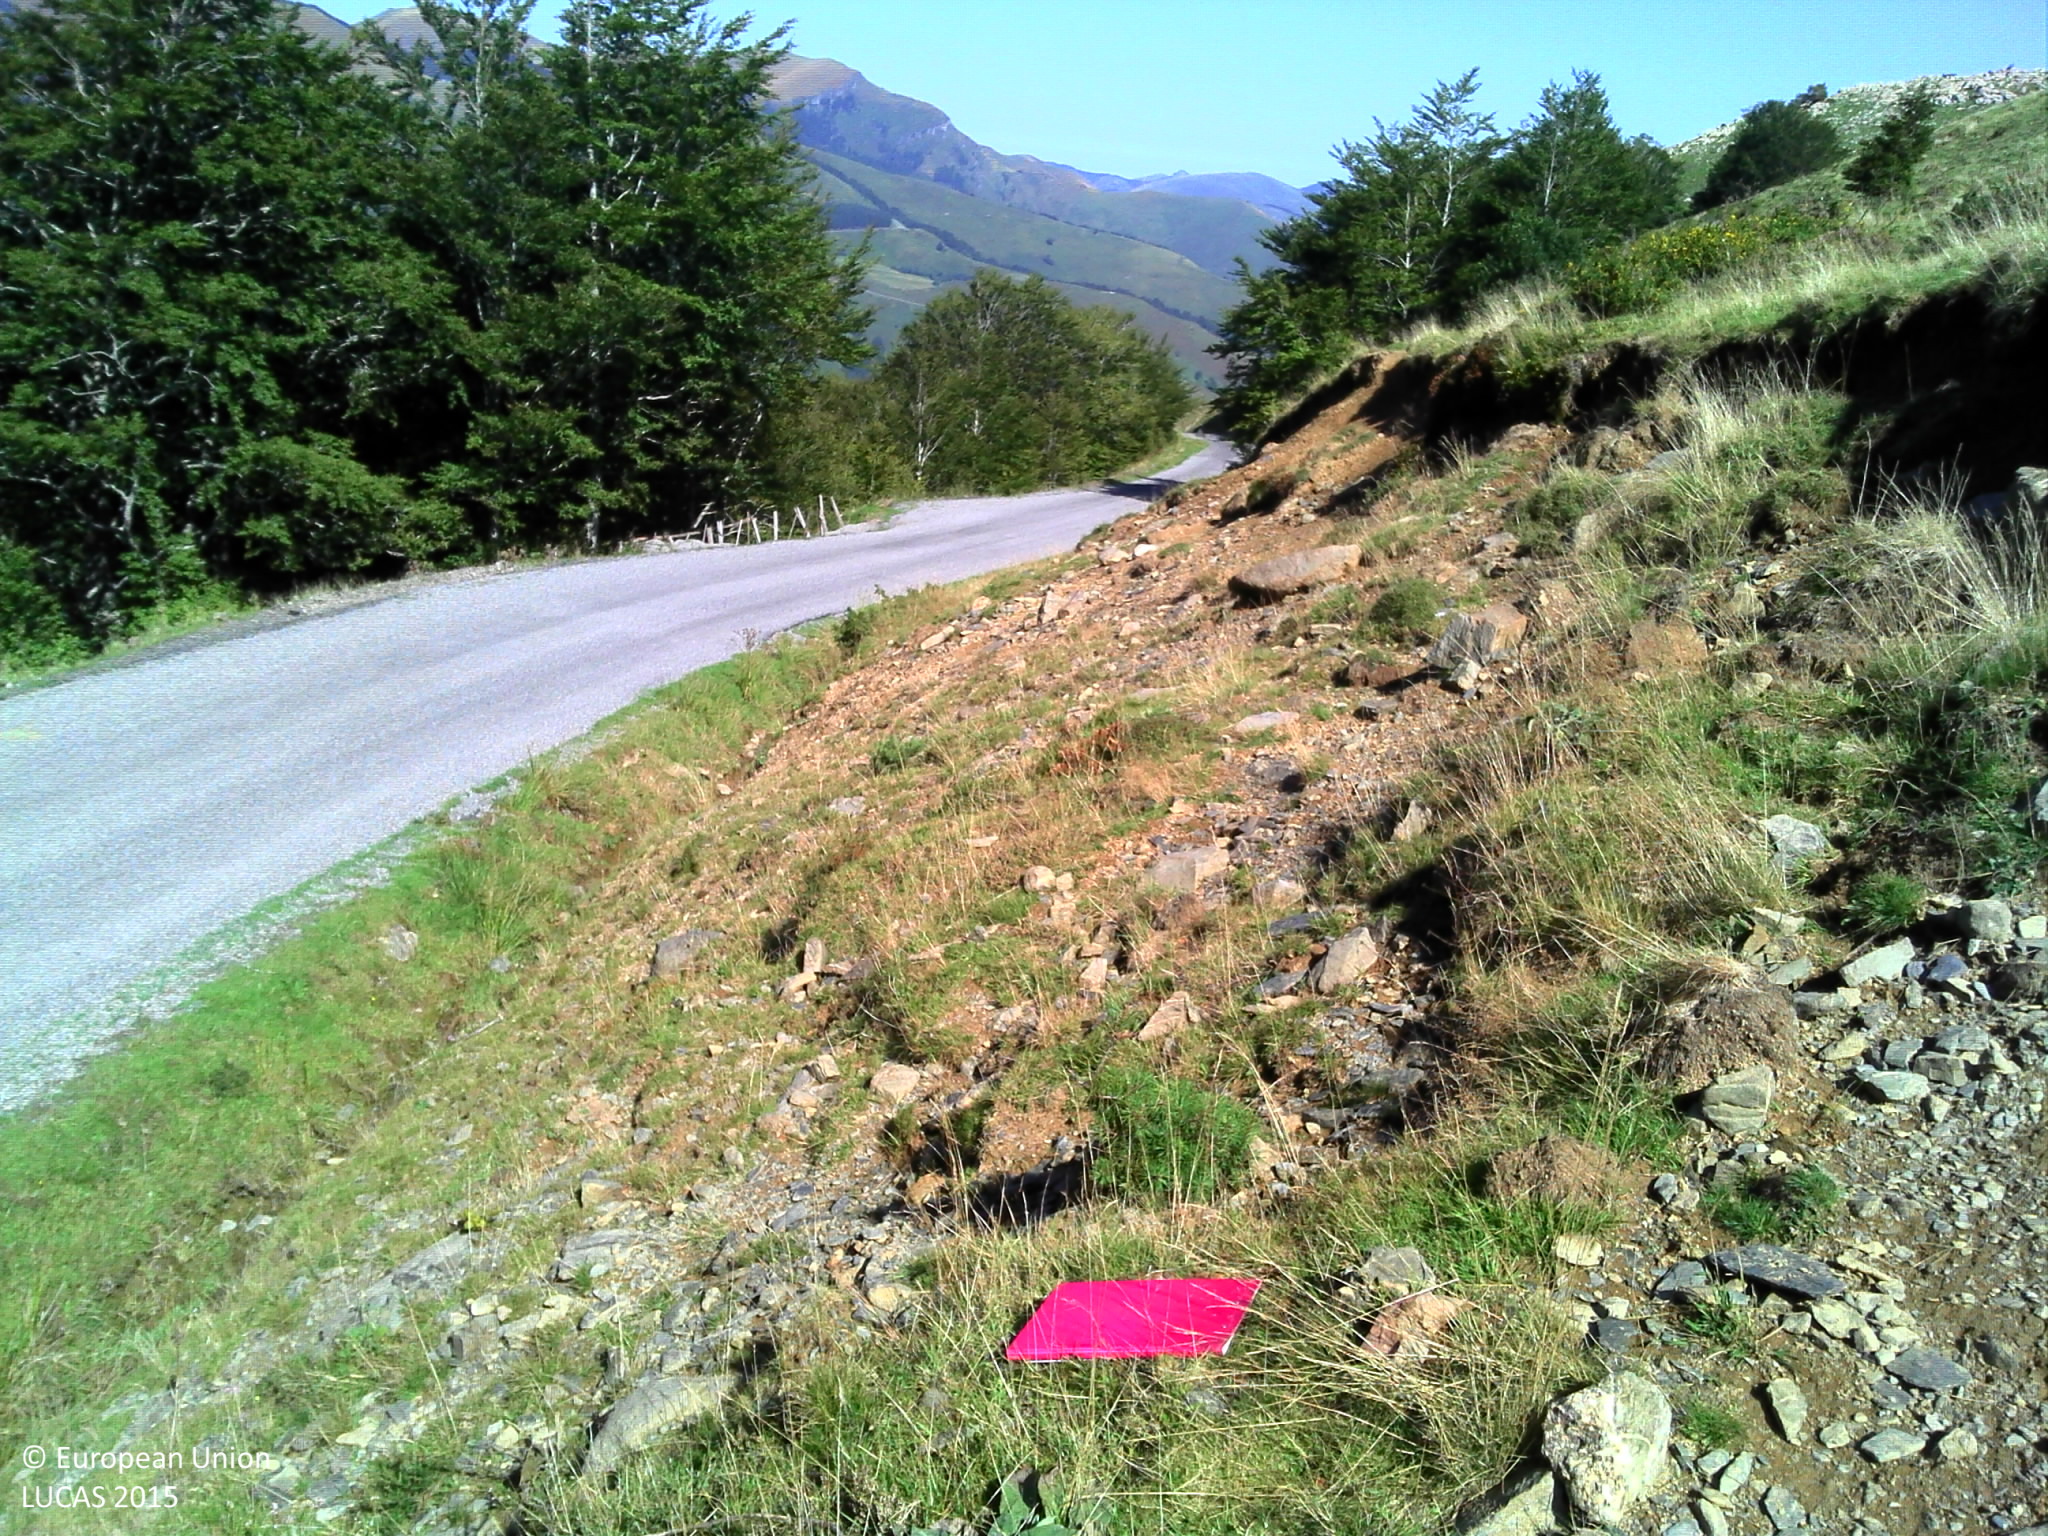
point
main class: Grassland
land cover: Spontaneously vegetated surfaces
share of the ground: 50 - 75 %
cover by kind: herbaceous plants 55 %, unconsolidated bare surface 30 %, consolidated bare surface 10 %, shrubs 5 %
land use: Agriculture (excluding fallow land and kitchen gardens)
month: September
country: FR
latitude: 43.0010
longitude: -0.9887
